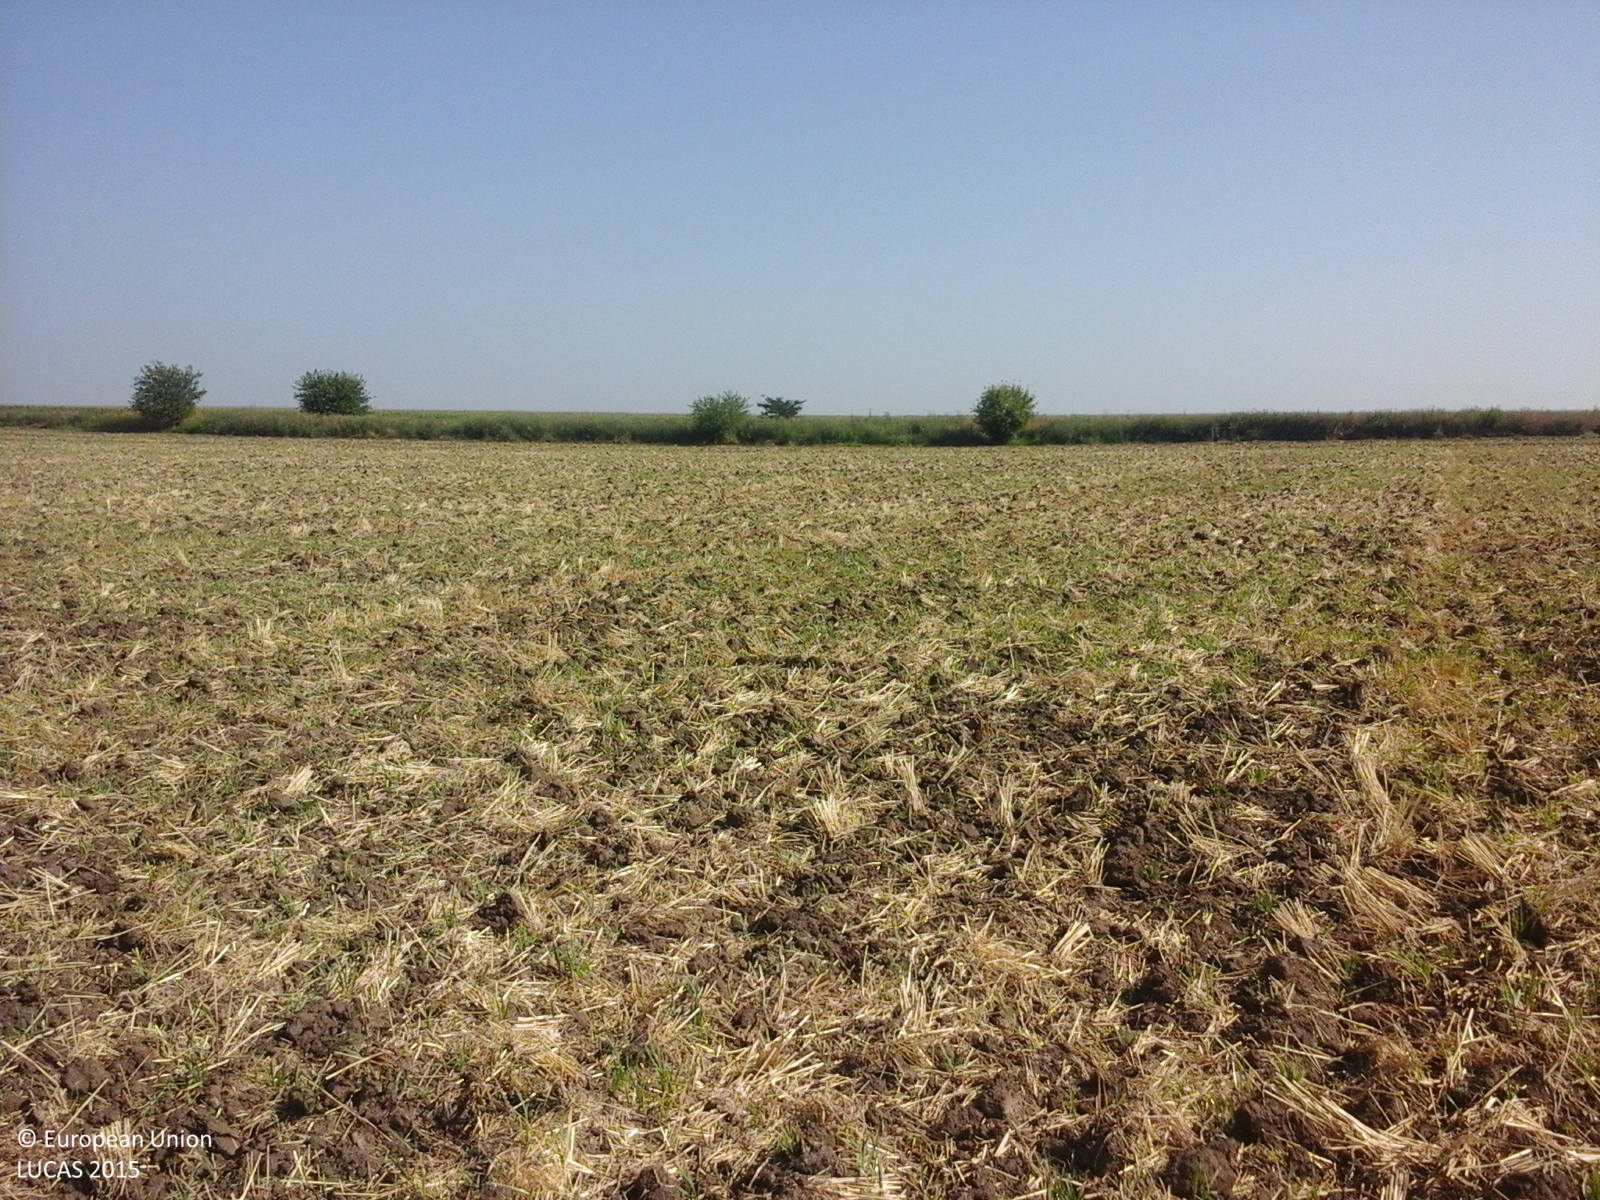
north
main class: Cropland
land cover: Common wheat
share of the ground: 10 - 25 %
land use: Agriculture (excluding fallow land and kitchen gardens)
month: July
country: RO
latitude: 44.3922
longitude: 27.0904
